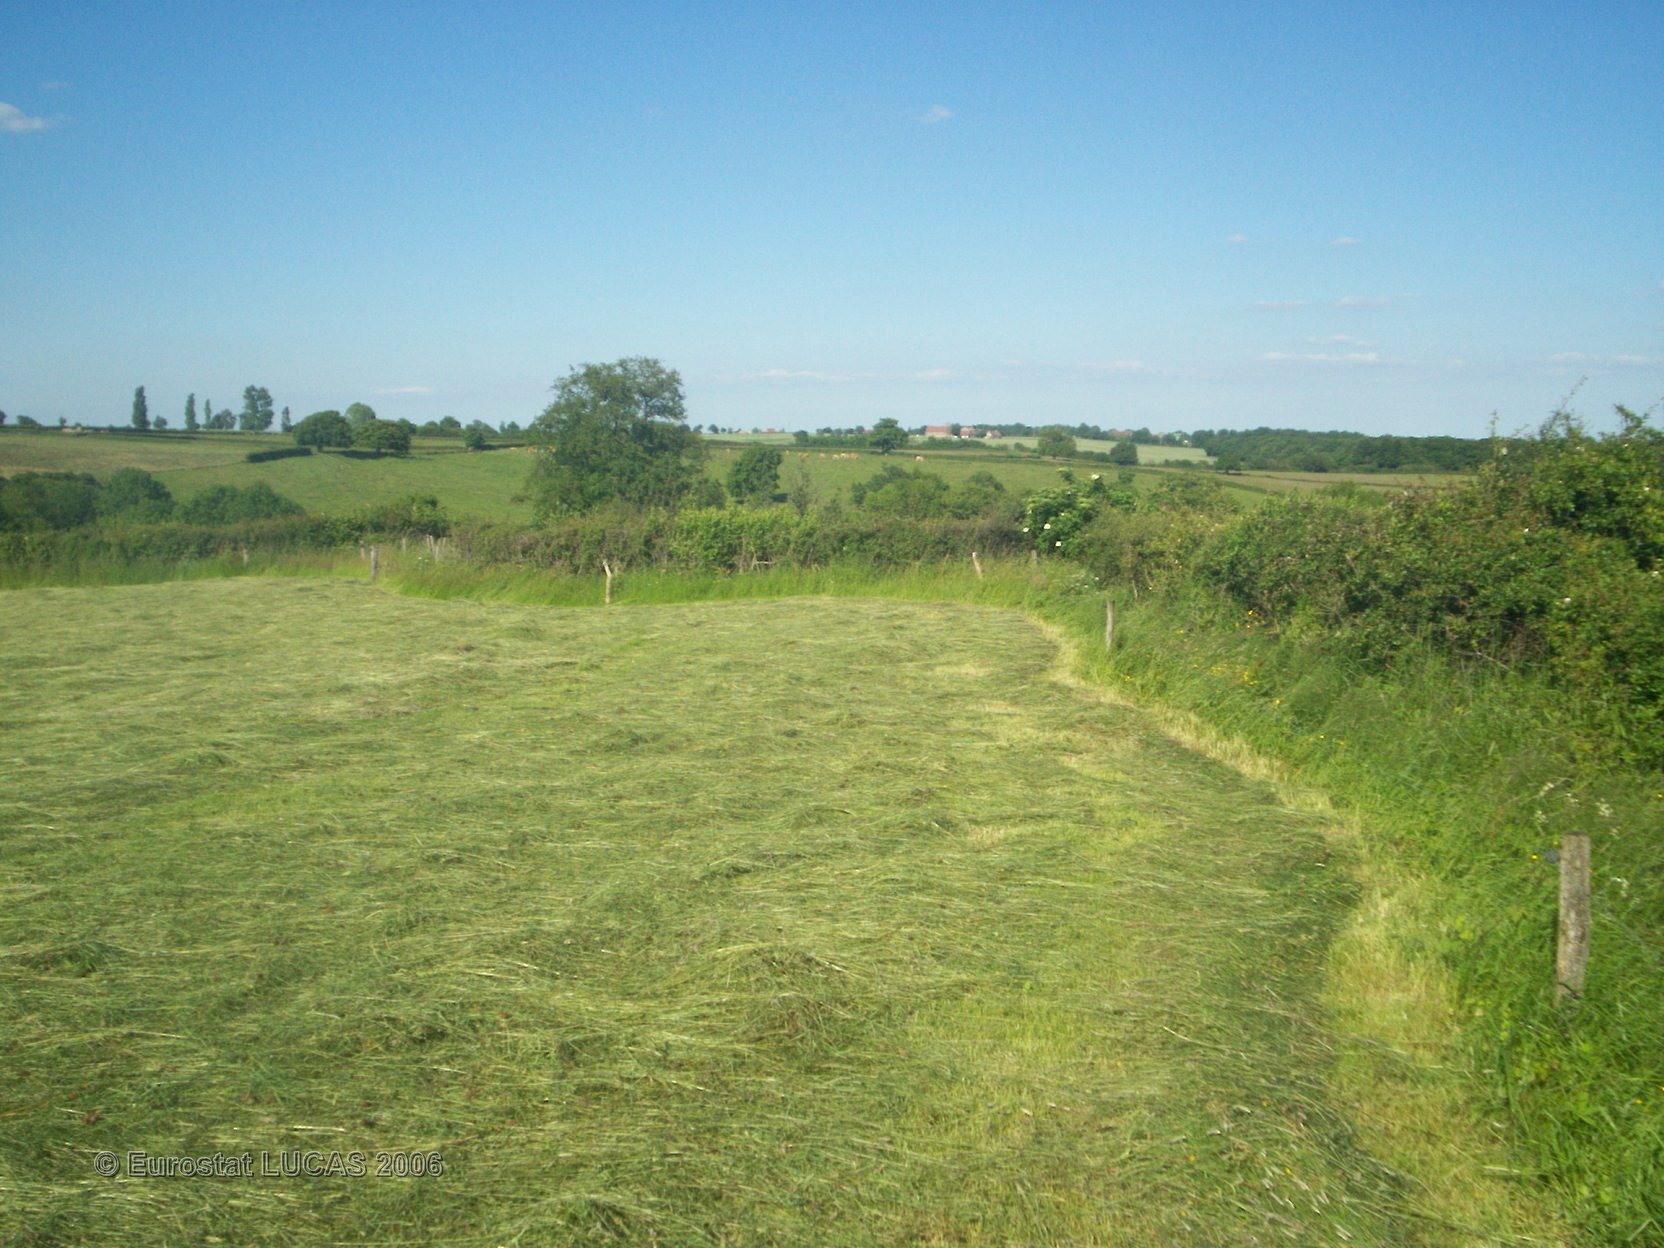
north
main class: Grassland
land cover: Grassland without tree/shrub cover
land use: Agriculture (excluding fallow land and kitchen gardens)
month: June
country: FR
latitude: 46.3126
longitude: 3.1548
